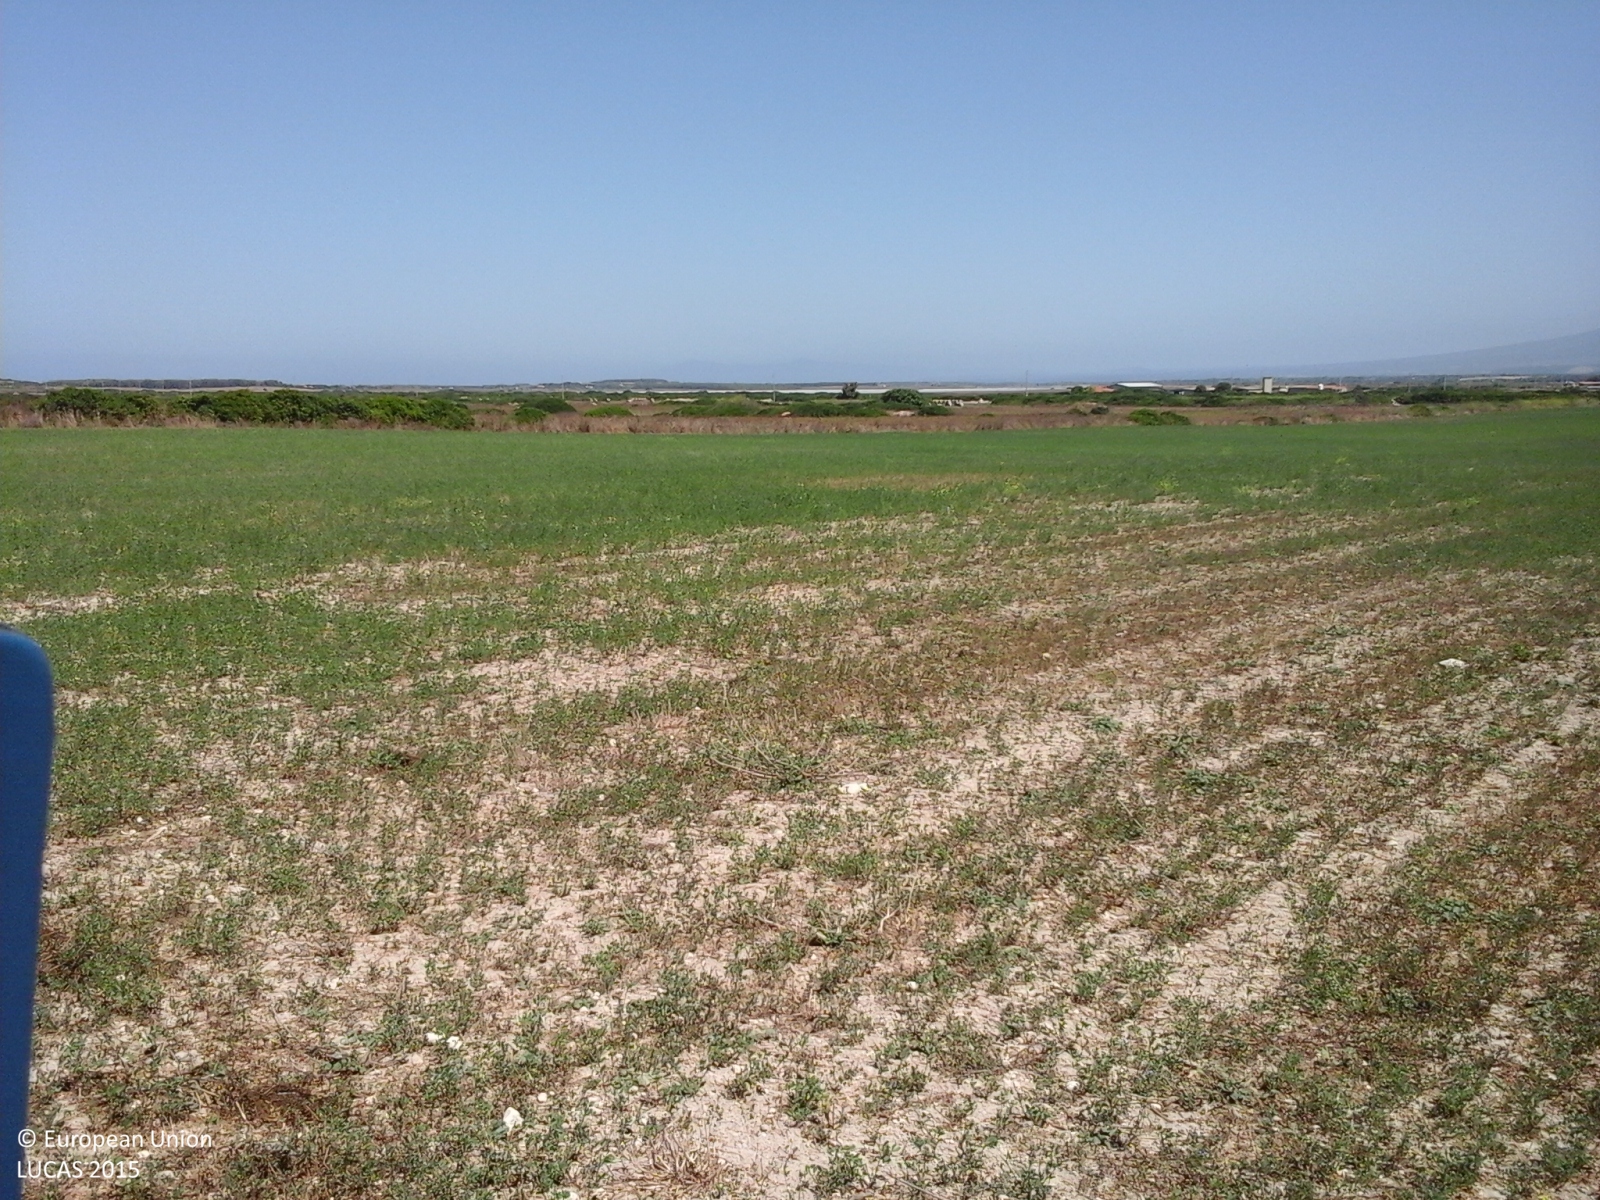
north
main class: Cropland
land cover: Lucerne
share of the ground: > 75 %
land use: Agriculture (excluding fallow land and kitchen gardens)
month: July
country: IT
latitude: 39.9831
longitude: 8.4277
